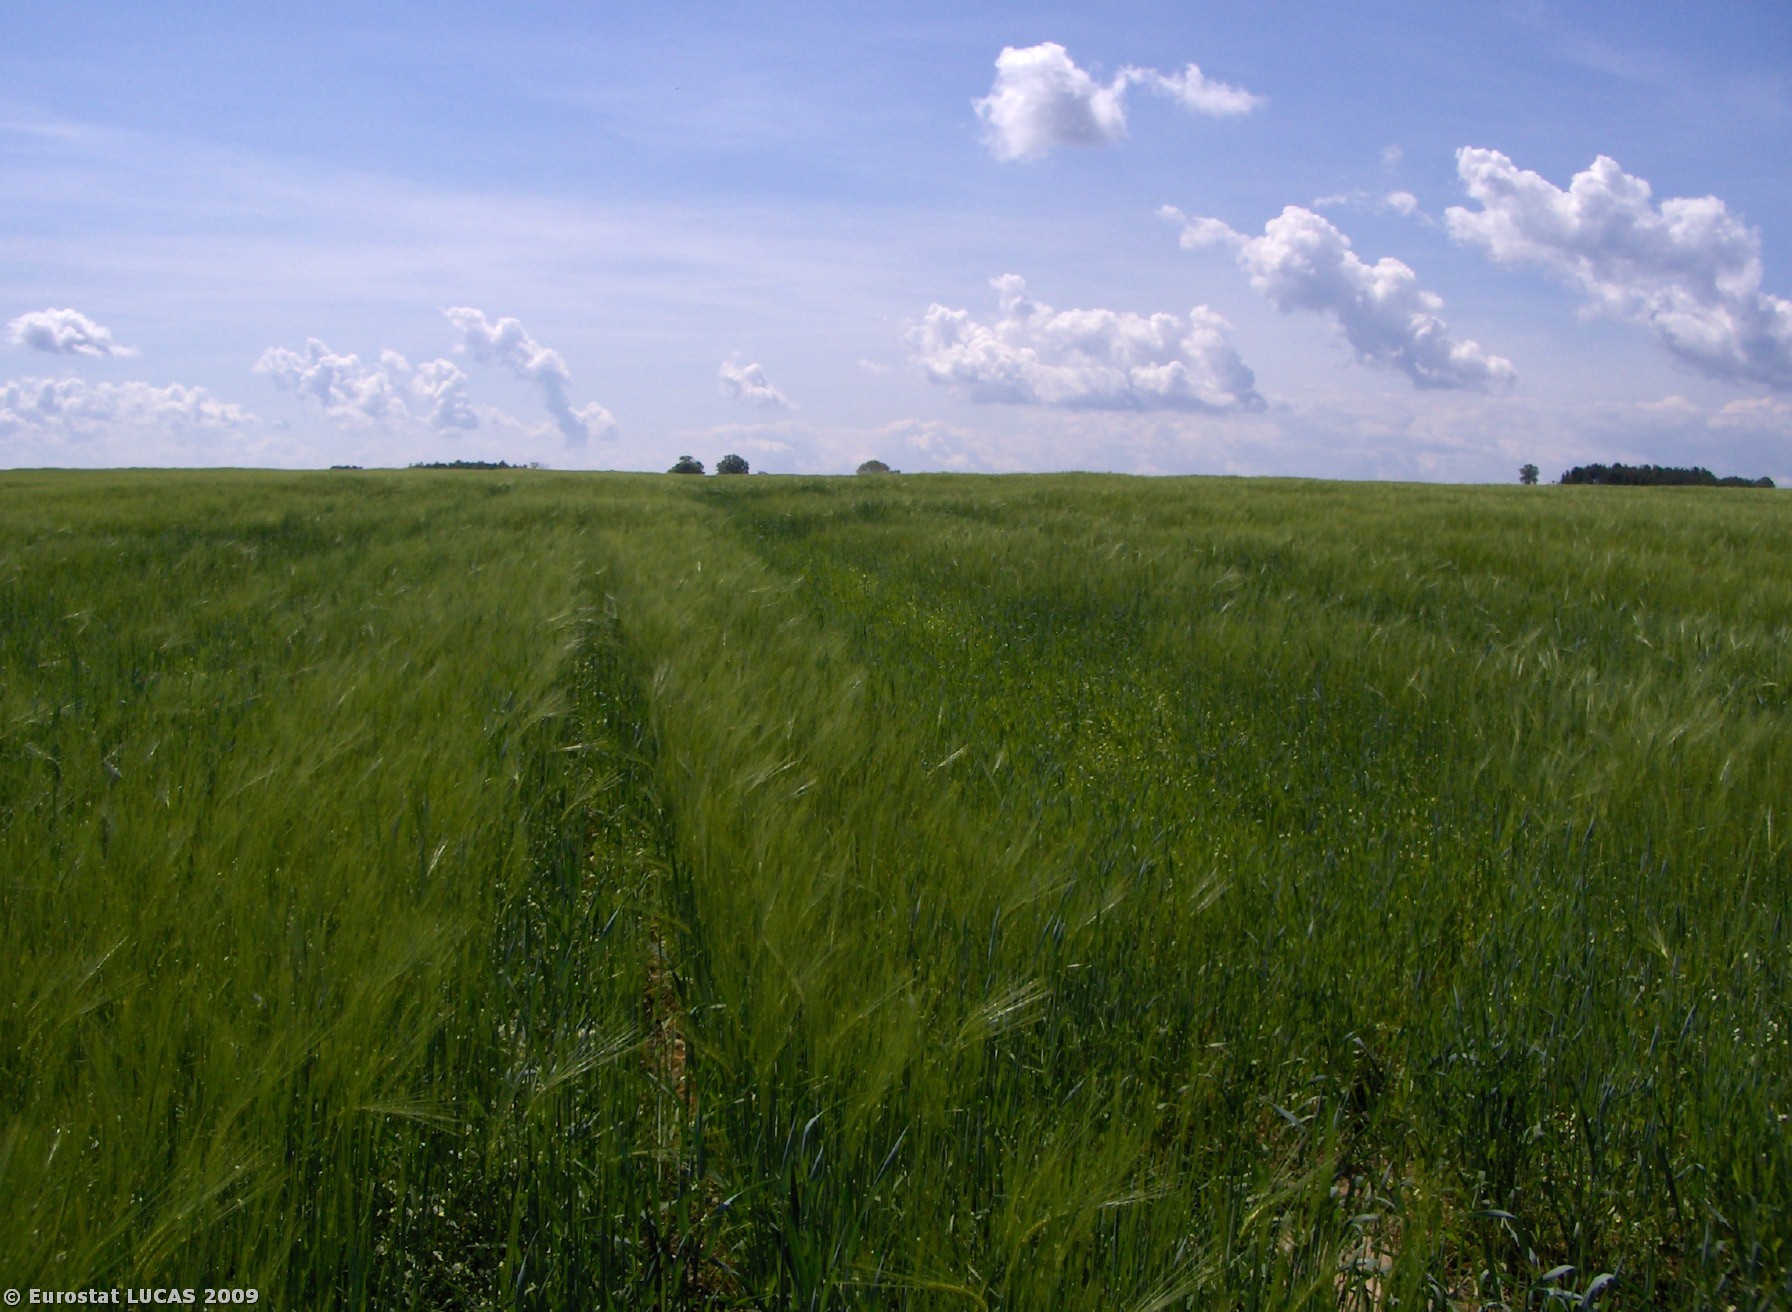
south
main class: Cropland
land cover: Barley
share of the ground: > 75 %
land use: Agriculture (excluding fallow land and kitchen gardens)
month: May
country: CZ
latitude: 49.3992
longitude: 14.3417
